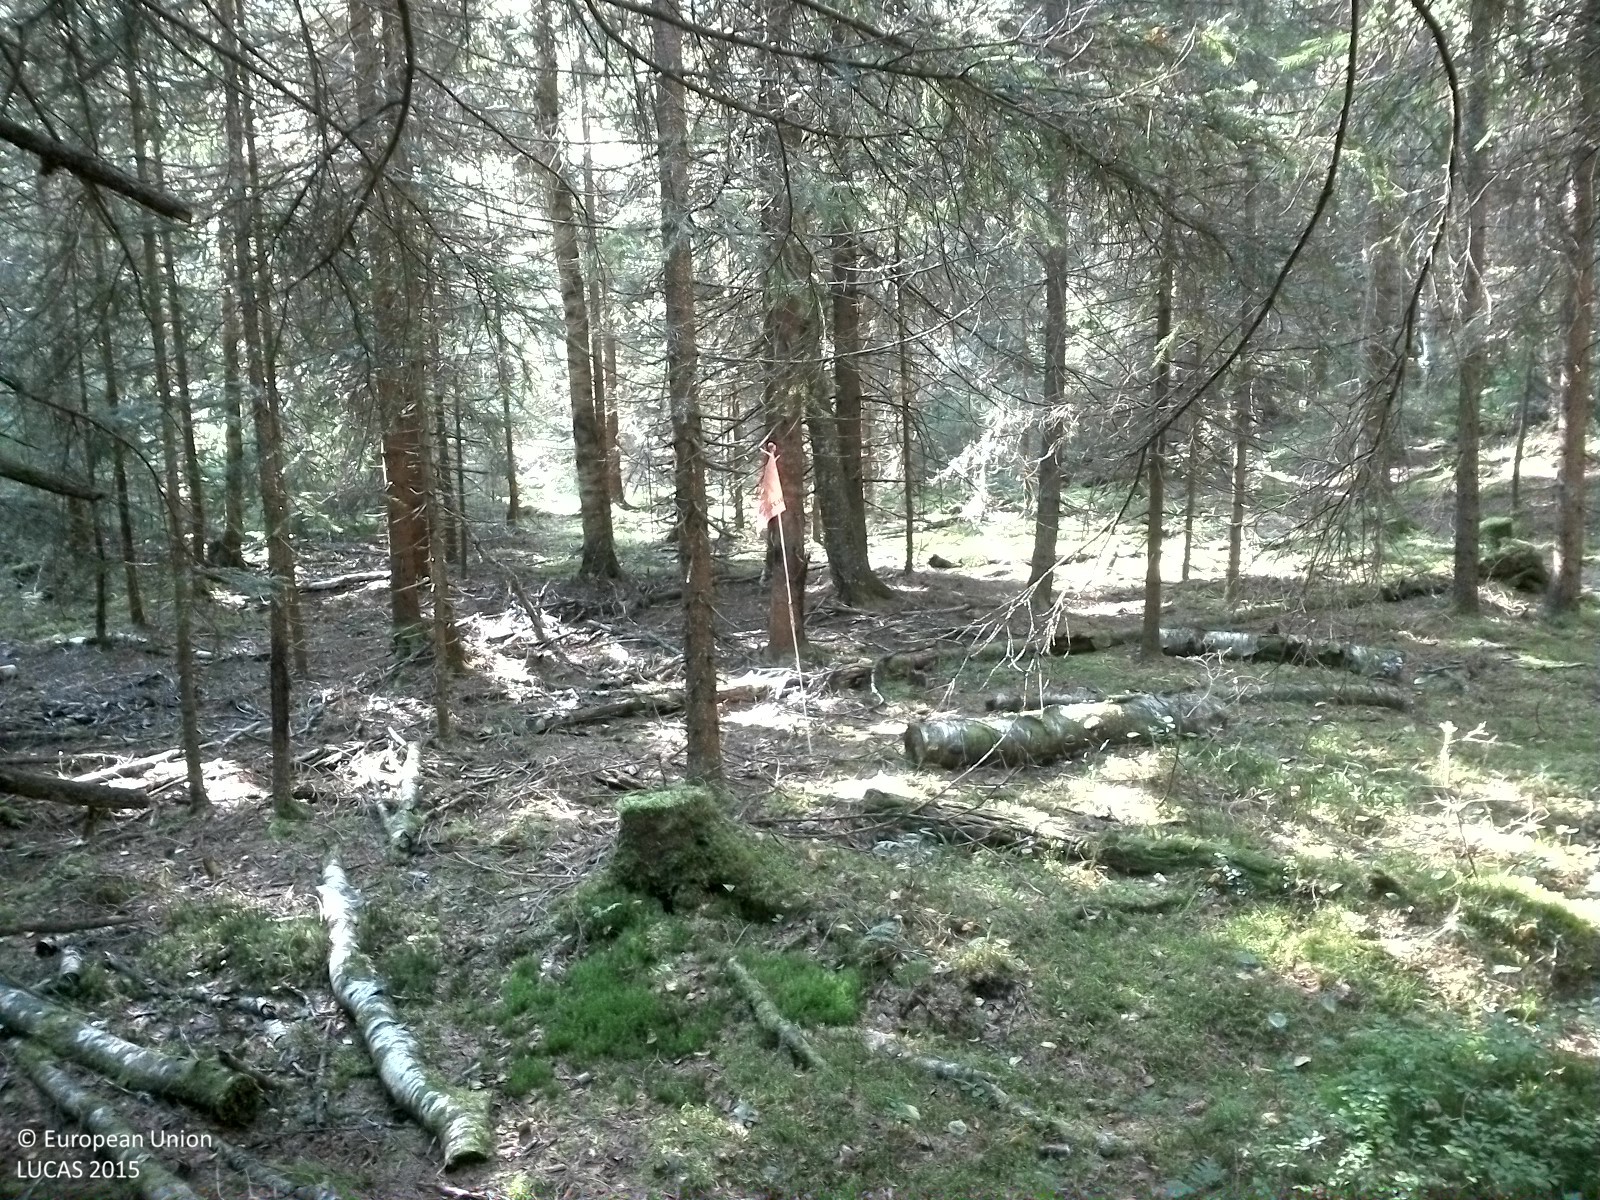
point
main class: Woodland
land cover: Spruce dominated mixed woodland
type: boreal forest
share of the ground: 50 - 75 %
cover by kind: coniferous forest trees 45 %, lichens and mosses 20 %, broadleaved forest trees 15 %, herbaceous plants 10 %, consolidated bare surface 10 %
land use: Forestry
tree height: < 5 m
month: August
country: SE
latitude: 58.7913
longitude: 15.0626
